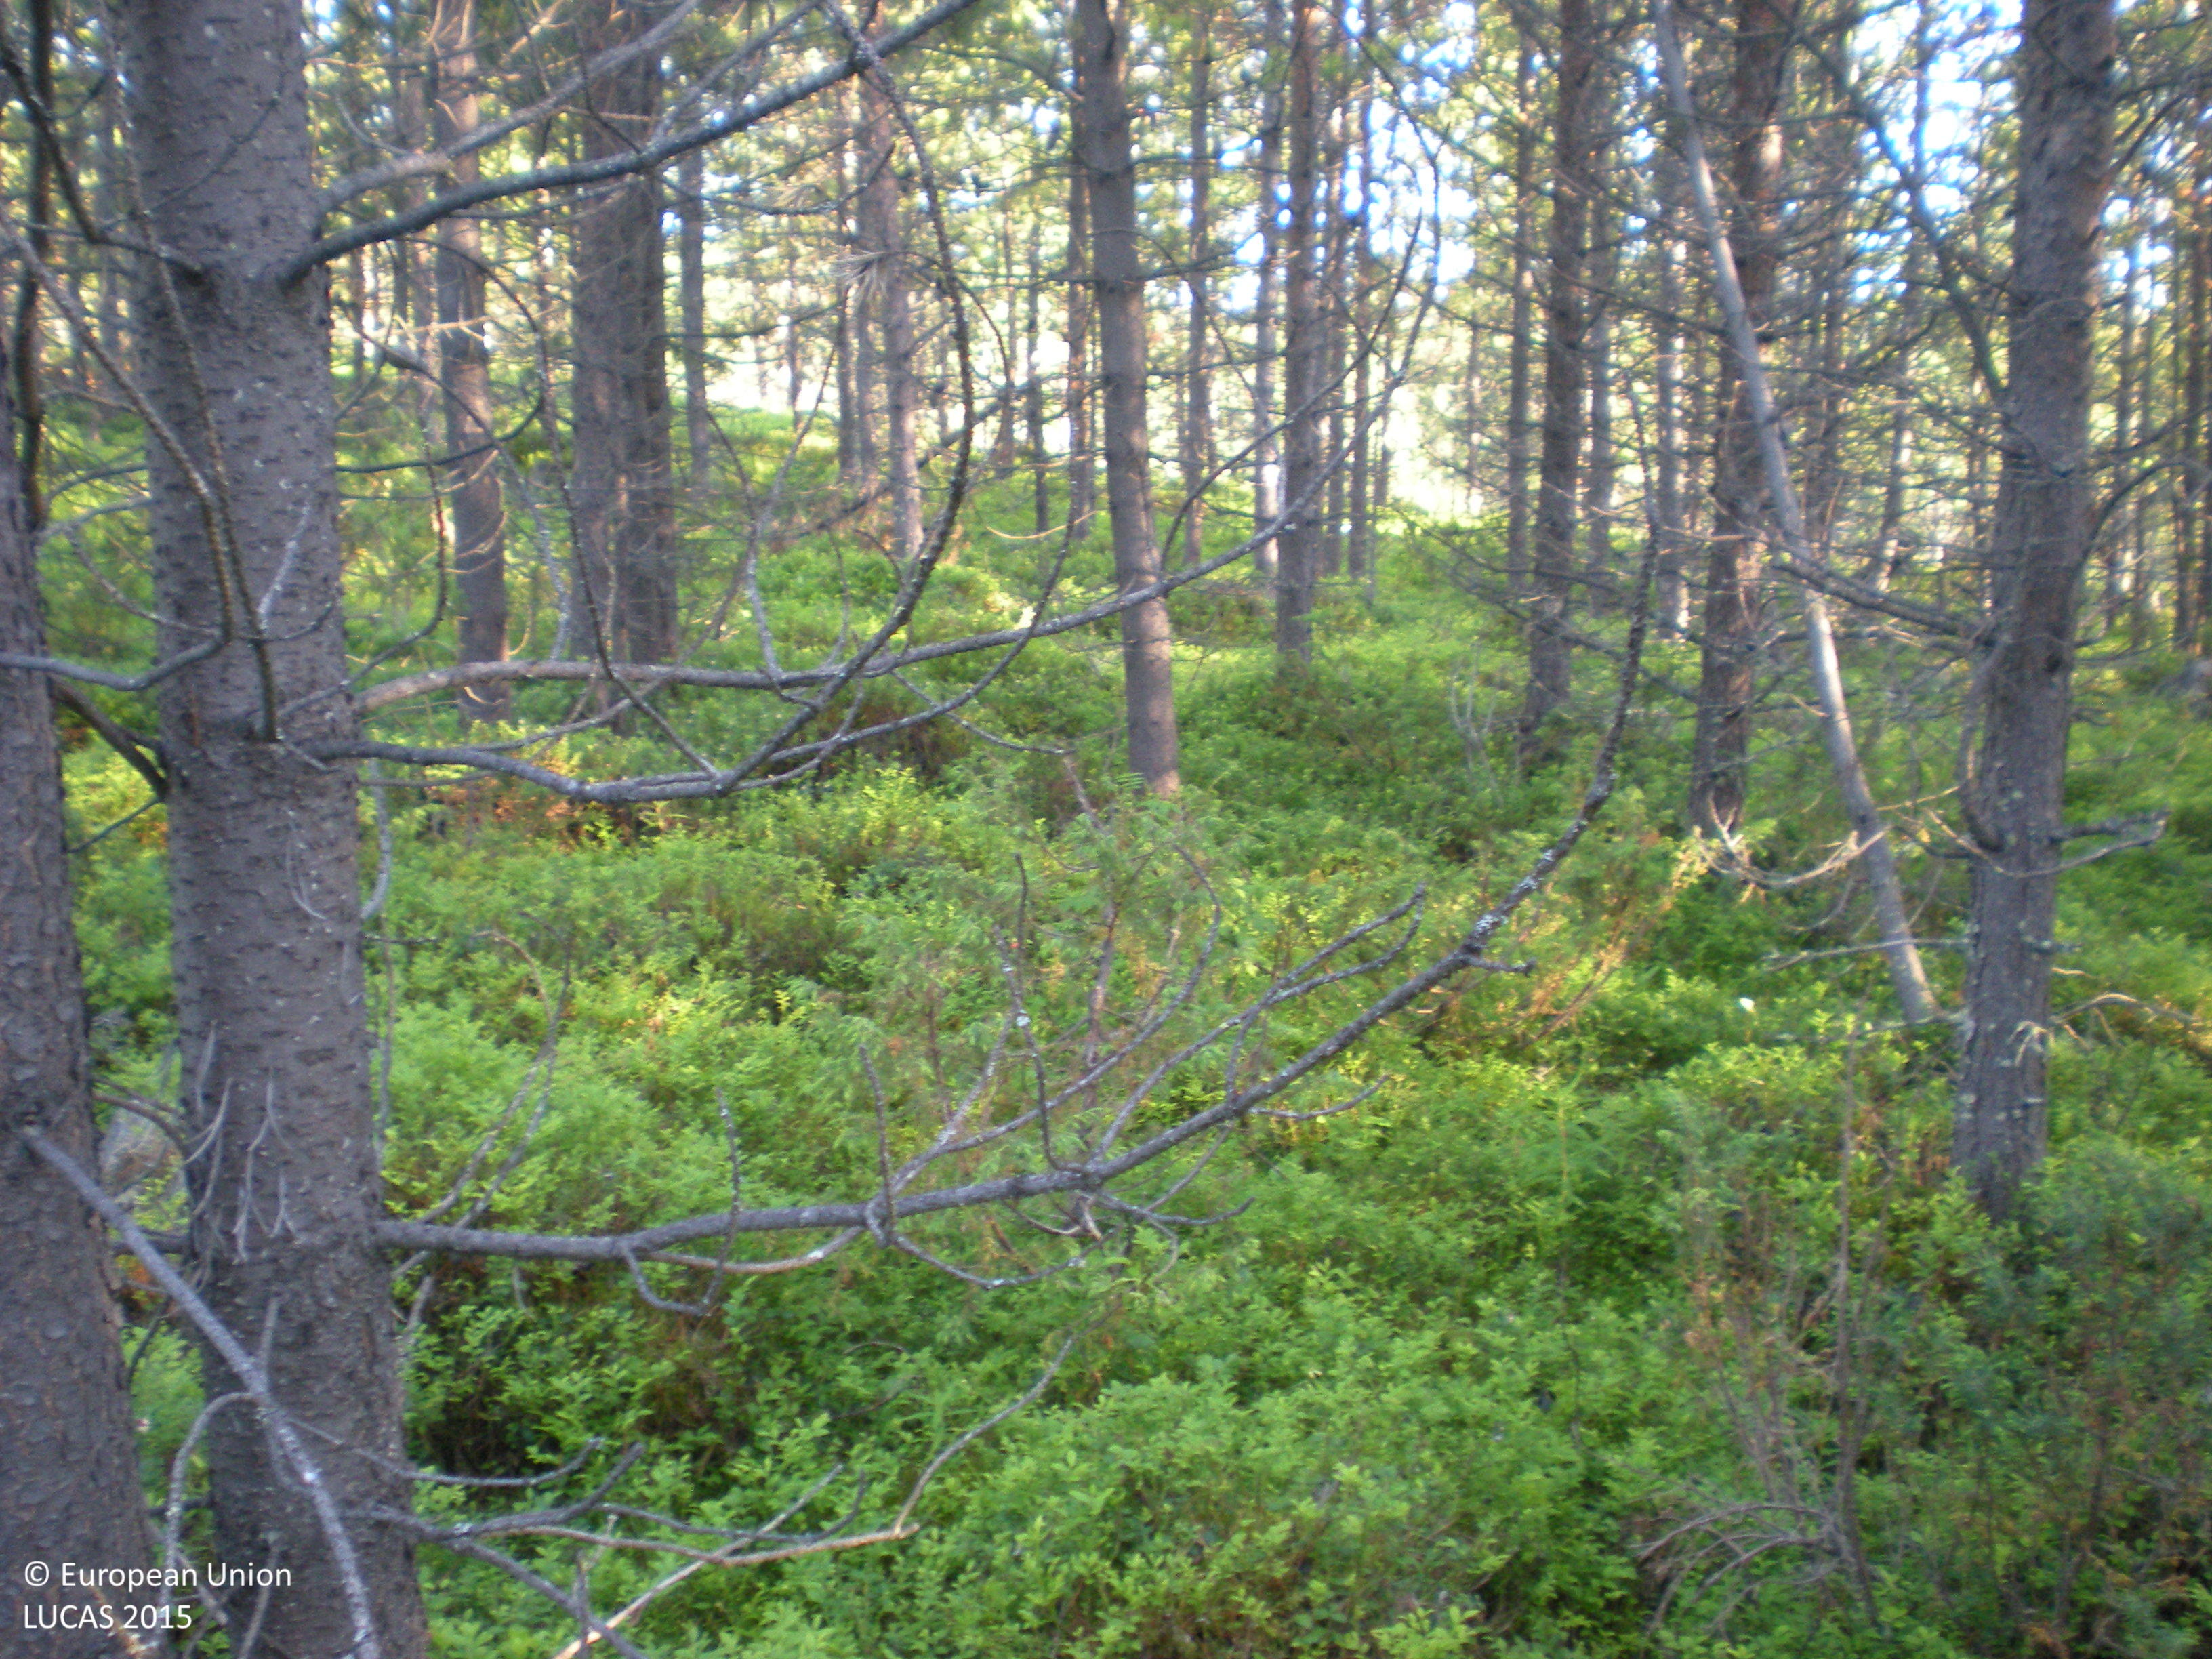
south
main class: Woodland
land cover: Pine dominated coniferous woodland
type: exotic forest
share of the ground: 50 - 75 %
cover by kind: coniferous forest trees 75 %, shrubs 20 %, consolidated bare surface 5 %
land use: Forestry
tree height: > 5 m
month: August
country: SE
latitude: 66.2672
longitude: 18.0360
